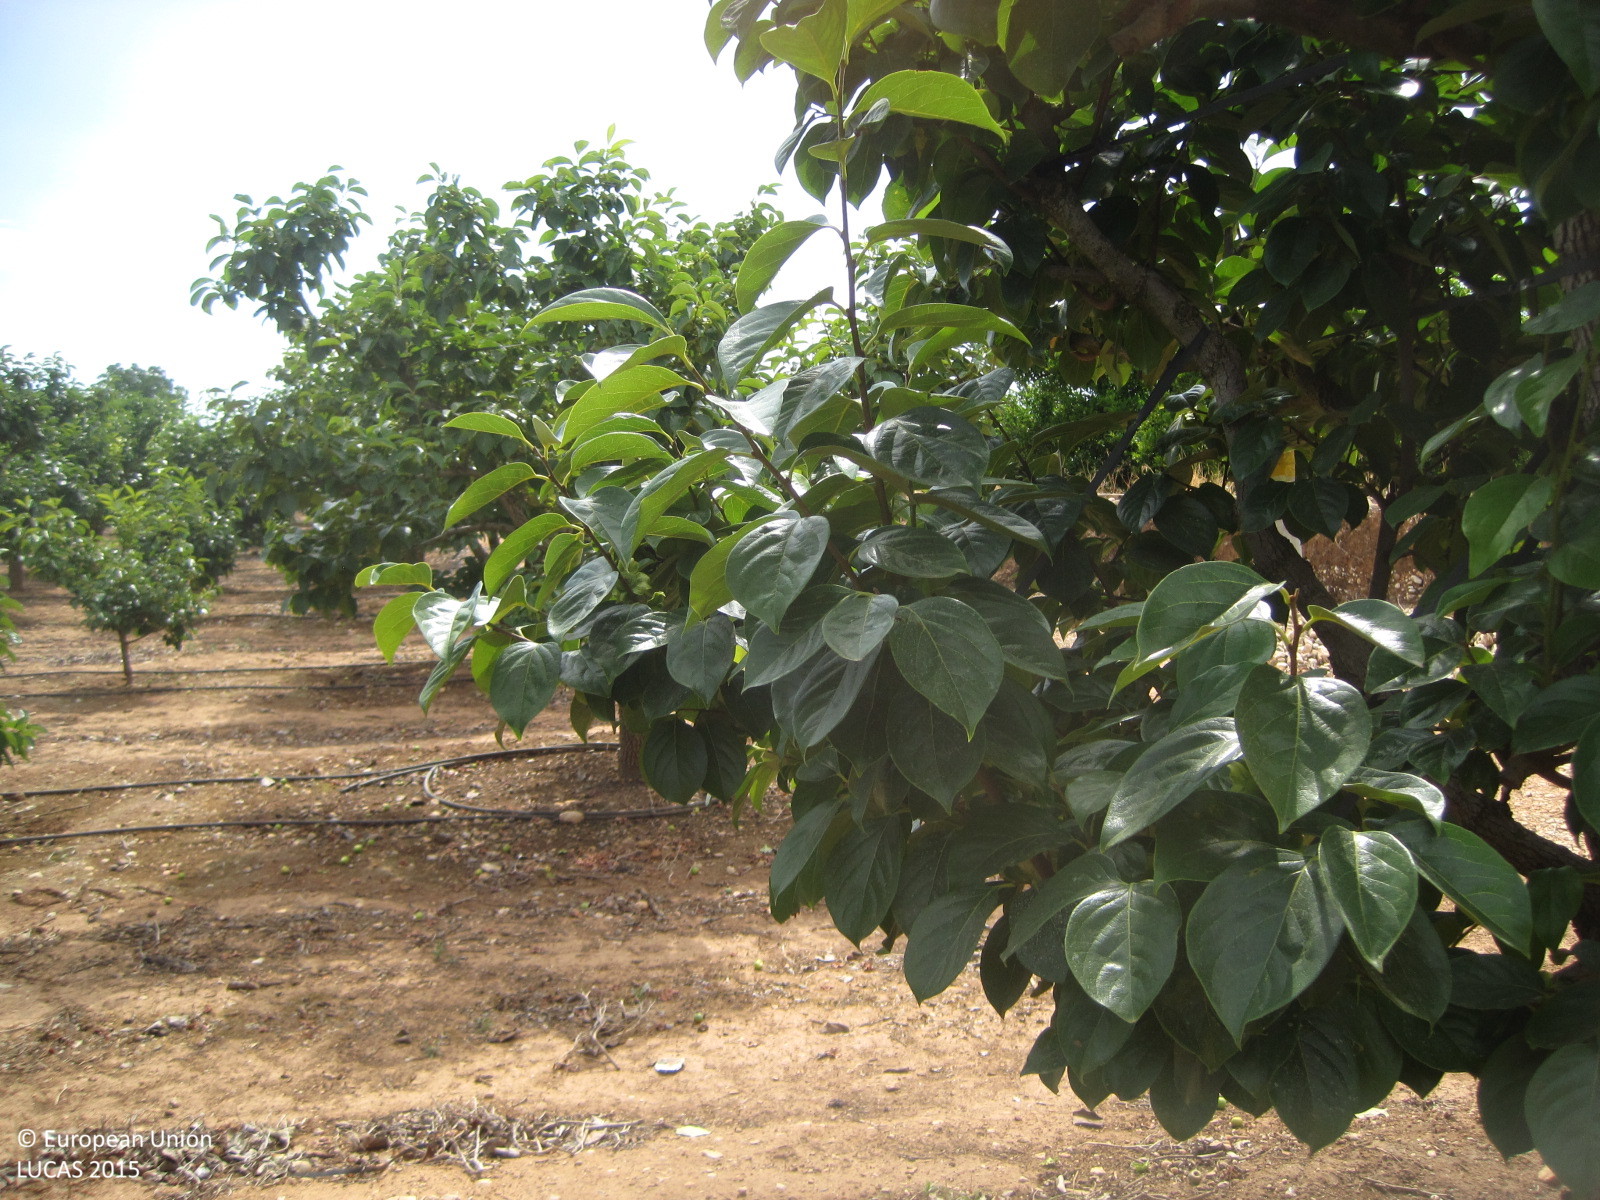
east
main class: Cropland
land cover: Other fruit trees and berries
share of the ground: 25 - 50 %
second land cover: Other bare soil
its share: > 75 %
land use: Agriculture (excluding fallow land and kitchen gardens)
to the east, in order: Other fruit trees and berries; Other bare soil; Electric lines; Other fruit trees and berries; Ditches and canals; Tracks; Ditches and canals; Other fruit trees and berries; Grass margins; Ditches and canals; Other citrus fruit; Artificial constructions; Other fruit trees and berries; Artificial constructions; Other fresh vegetables
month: June
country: ES
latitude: 39.1870
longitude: -0.5418
